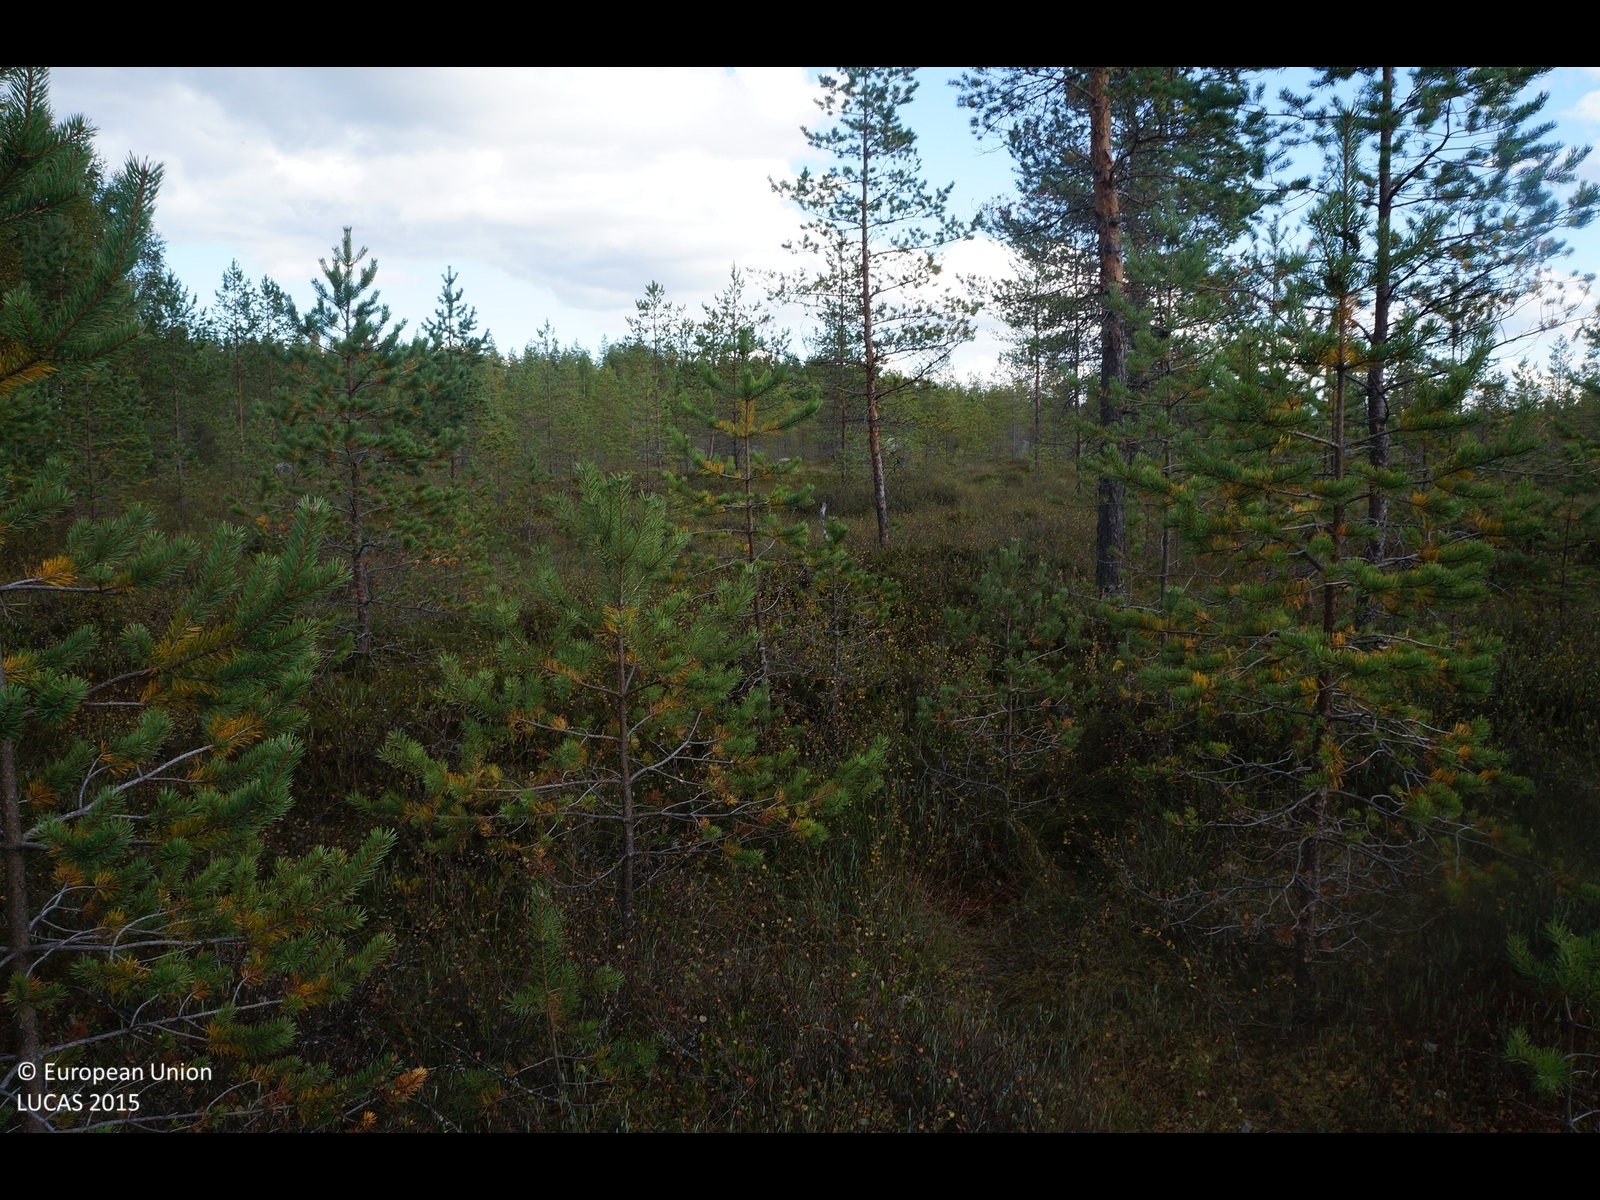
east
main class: Woodland
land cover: Pine dominated coniferous woodland
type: boreal forest
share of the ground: 25 - 50 %
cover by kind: shrubs 40 %, coniferous forest trees 30 %, lichens and mosses 30 %
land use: Forestry
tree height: > 5 m
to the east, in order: Pine dominated coniferous woodland; Tracks; Pine dominated coniferous woodland; Ditches and canals; Pine dominated mixed woodland; Pine dominated coniferous woodland
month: September
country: FI
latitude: 63.9526
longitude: 24.2564
